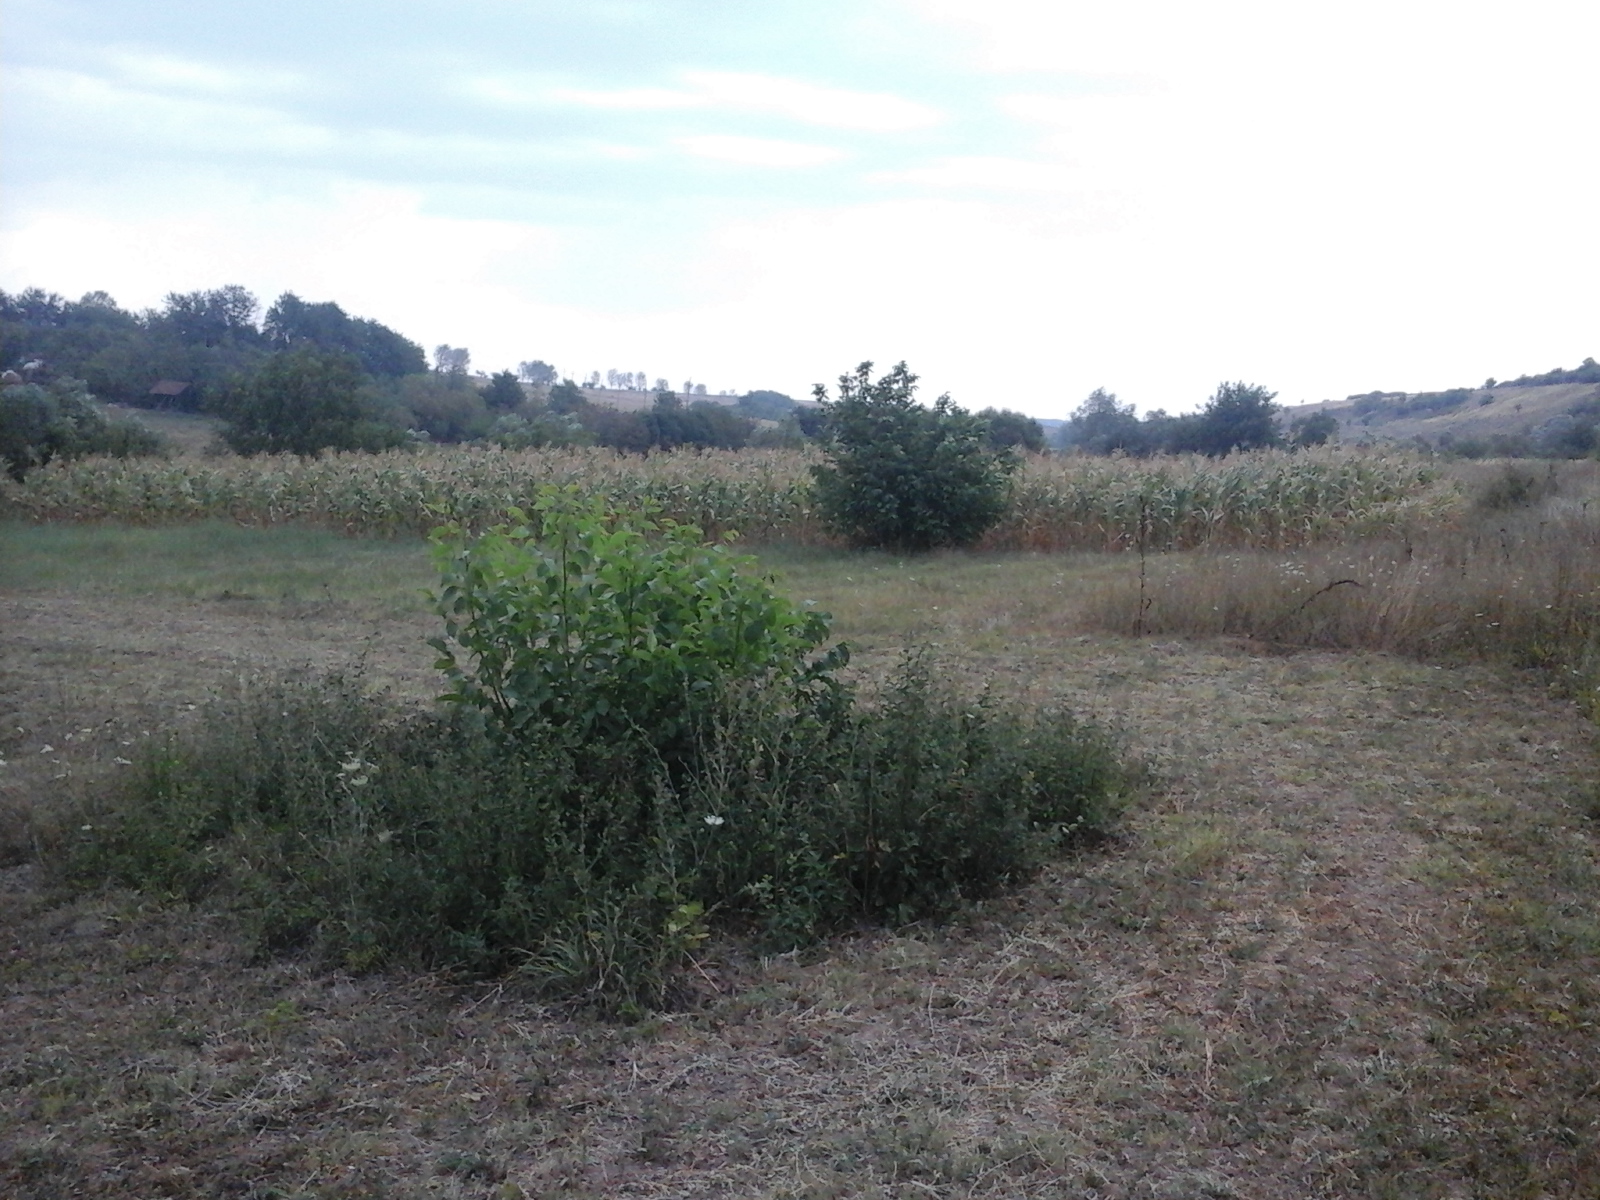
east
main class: Grassland
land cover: Grassland without tree/shrub cover
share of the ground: > 75 %
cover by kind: herbaceous plants 100 %
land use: Agriculture (excluding fallow land and kitchen gardens)
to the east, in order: Grassland without tree/shrub cover; Maize; Spontaneously vegetated surfaces; Grassland without tree/shrub cover; Tracks; Shruby margins; Abandoned hedges; Rivers and streams; Spontaneously vegetated surfaces; Tracks; Spontaneously vegetated surfaces
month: August
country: RO
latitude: 44.3327
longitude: 23.2793
